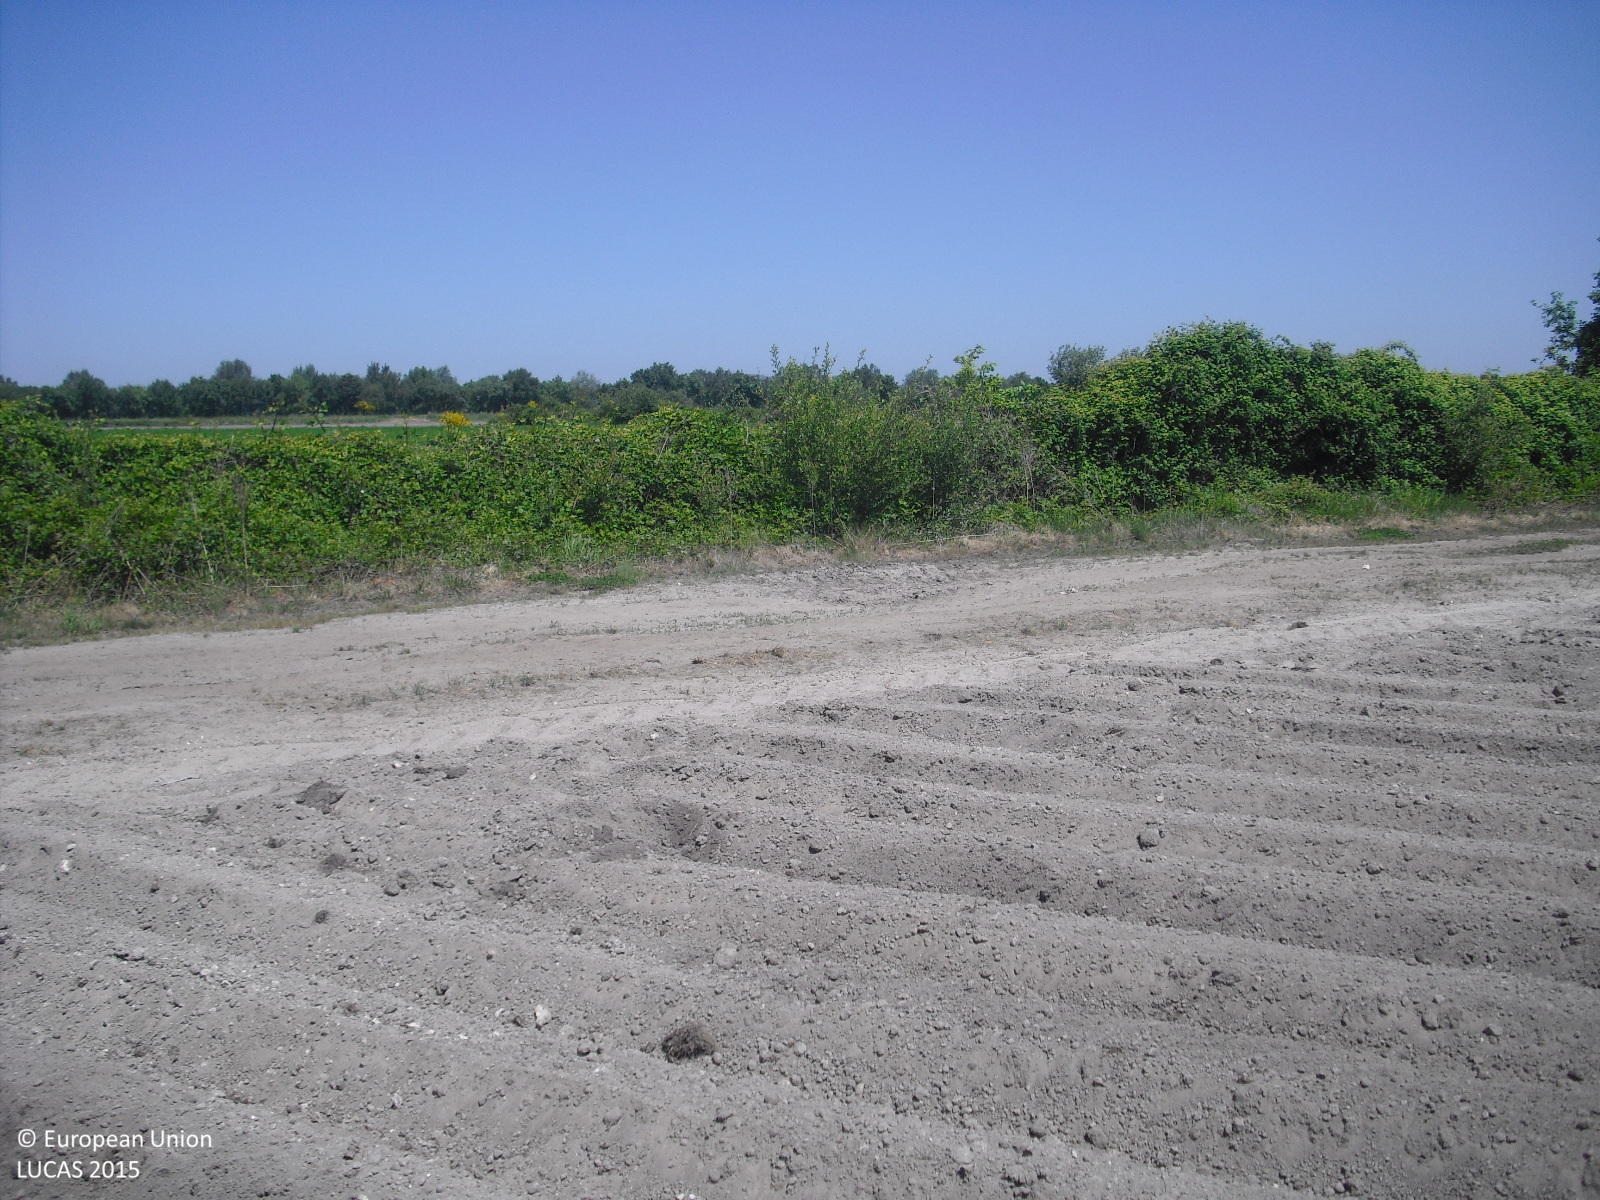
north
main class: Cropland
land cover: Potatoes
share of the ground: < 10 %
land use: Agriculture (excluding fallow land and kitchen gardens)
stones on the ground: < 10 %
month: May
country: ES
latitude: 42.1150
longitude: -7.6910
